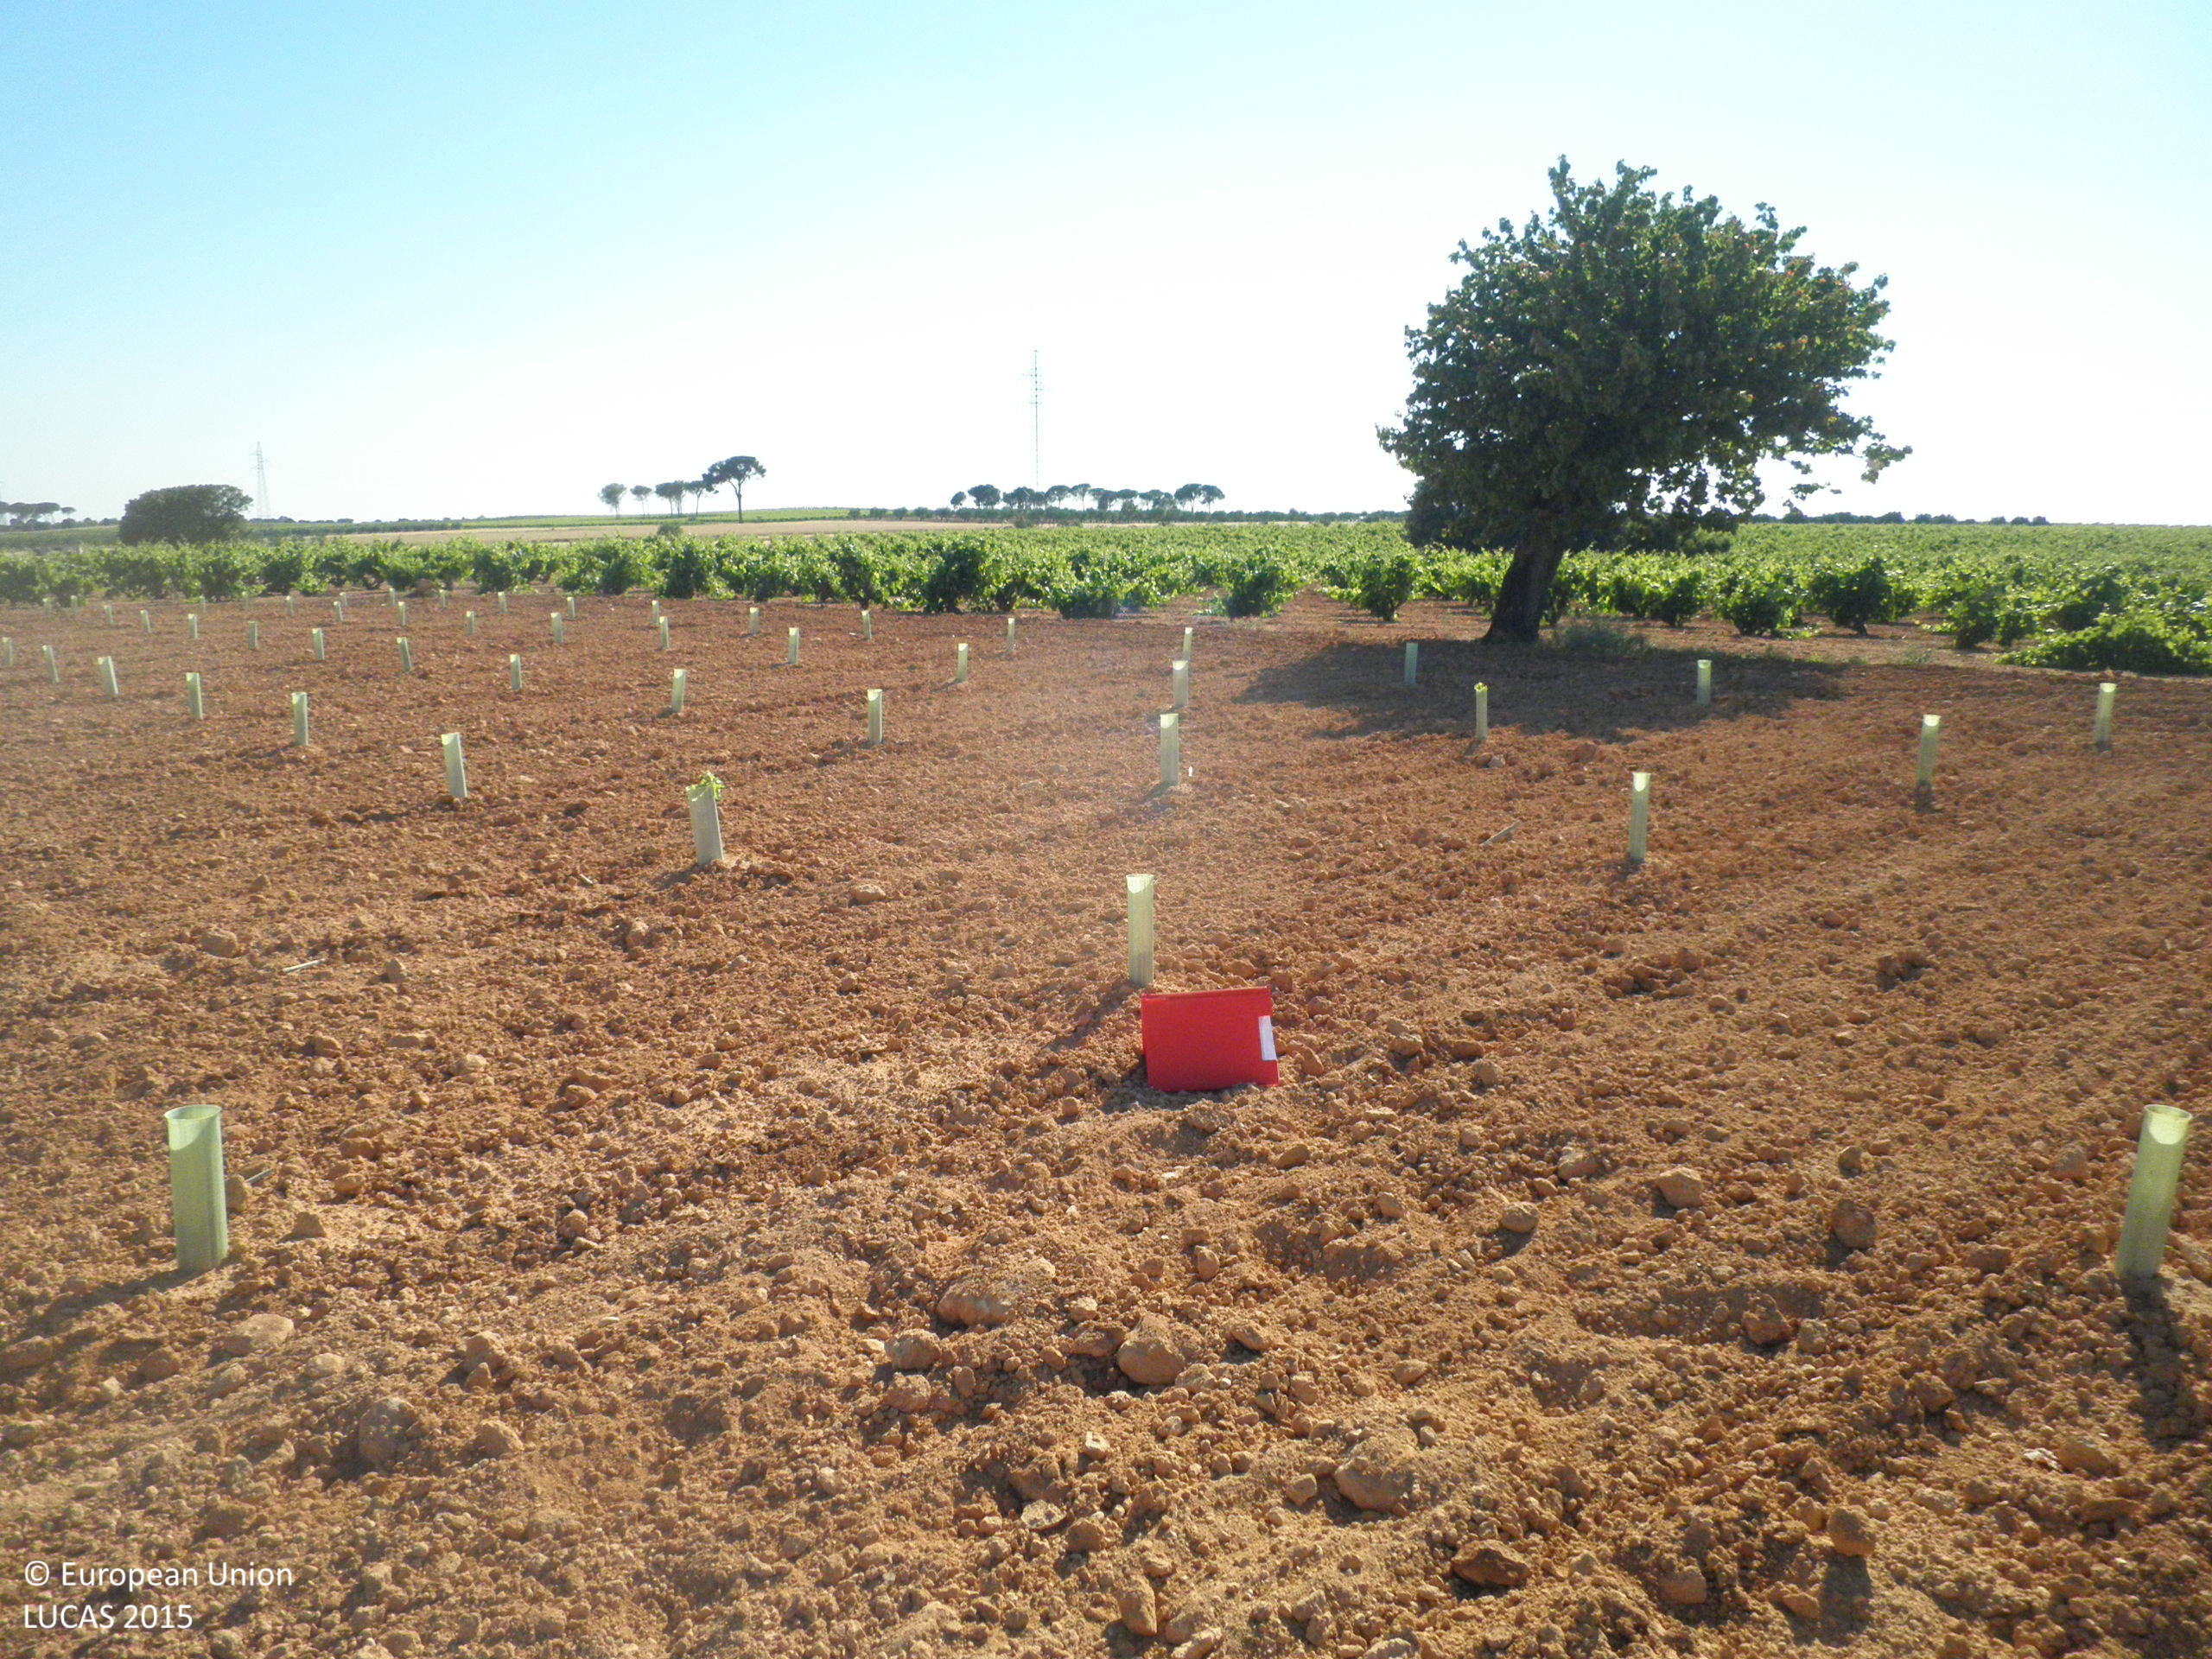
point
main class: Cropland
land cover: Vineyards
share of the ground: < 10 %
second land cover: Other bare soil
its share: > 75 %
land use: Agriculture (excluding fallow land and kitchen gardens)
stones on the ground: < 10 %
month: June
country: ES
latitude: 39.4033
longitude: -1.6751
